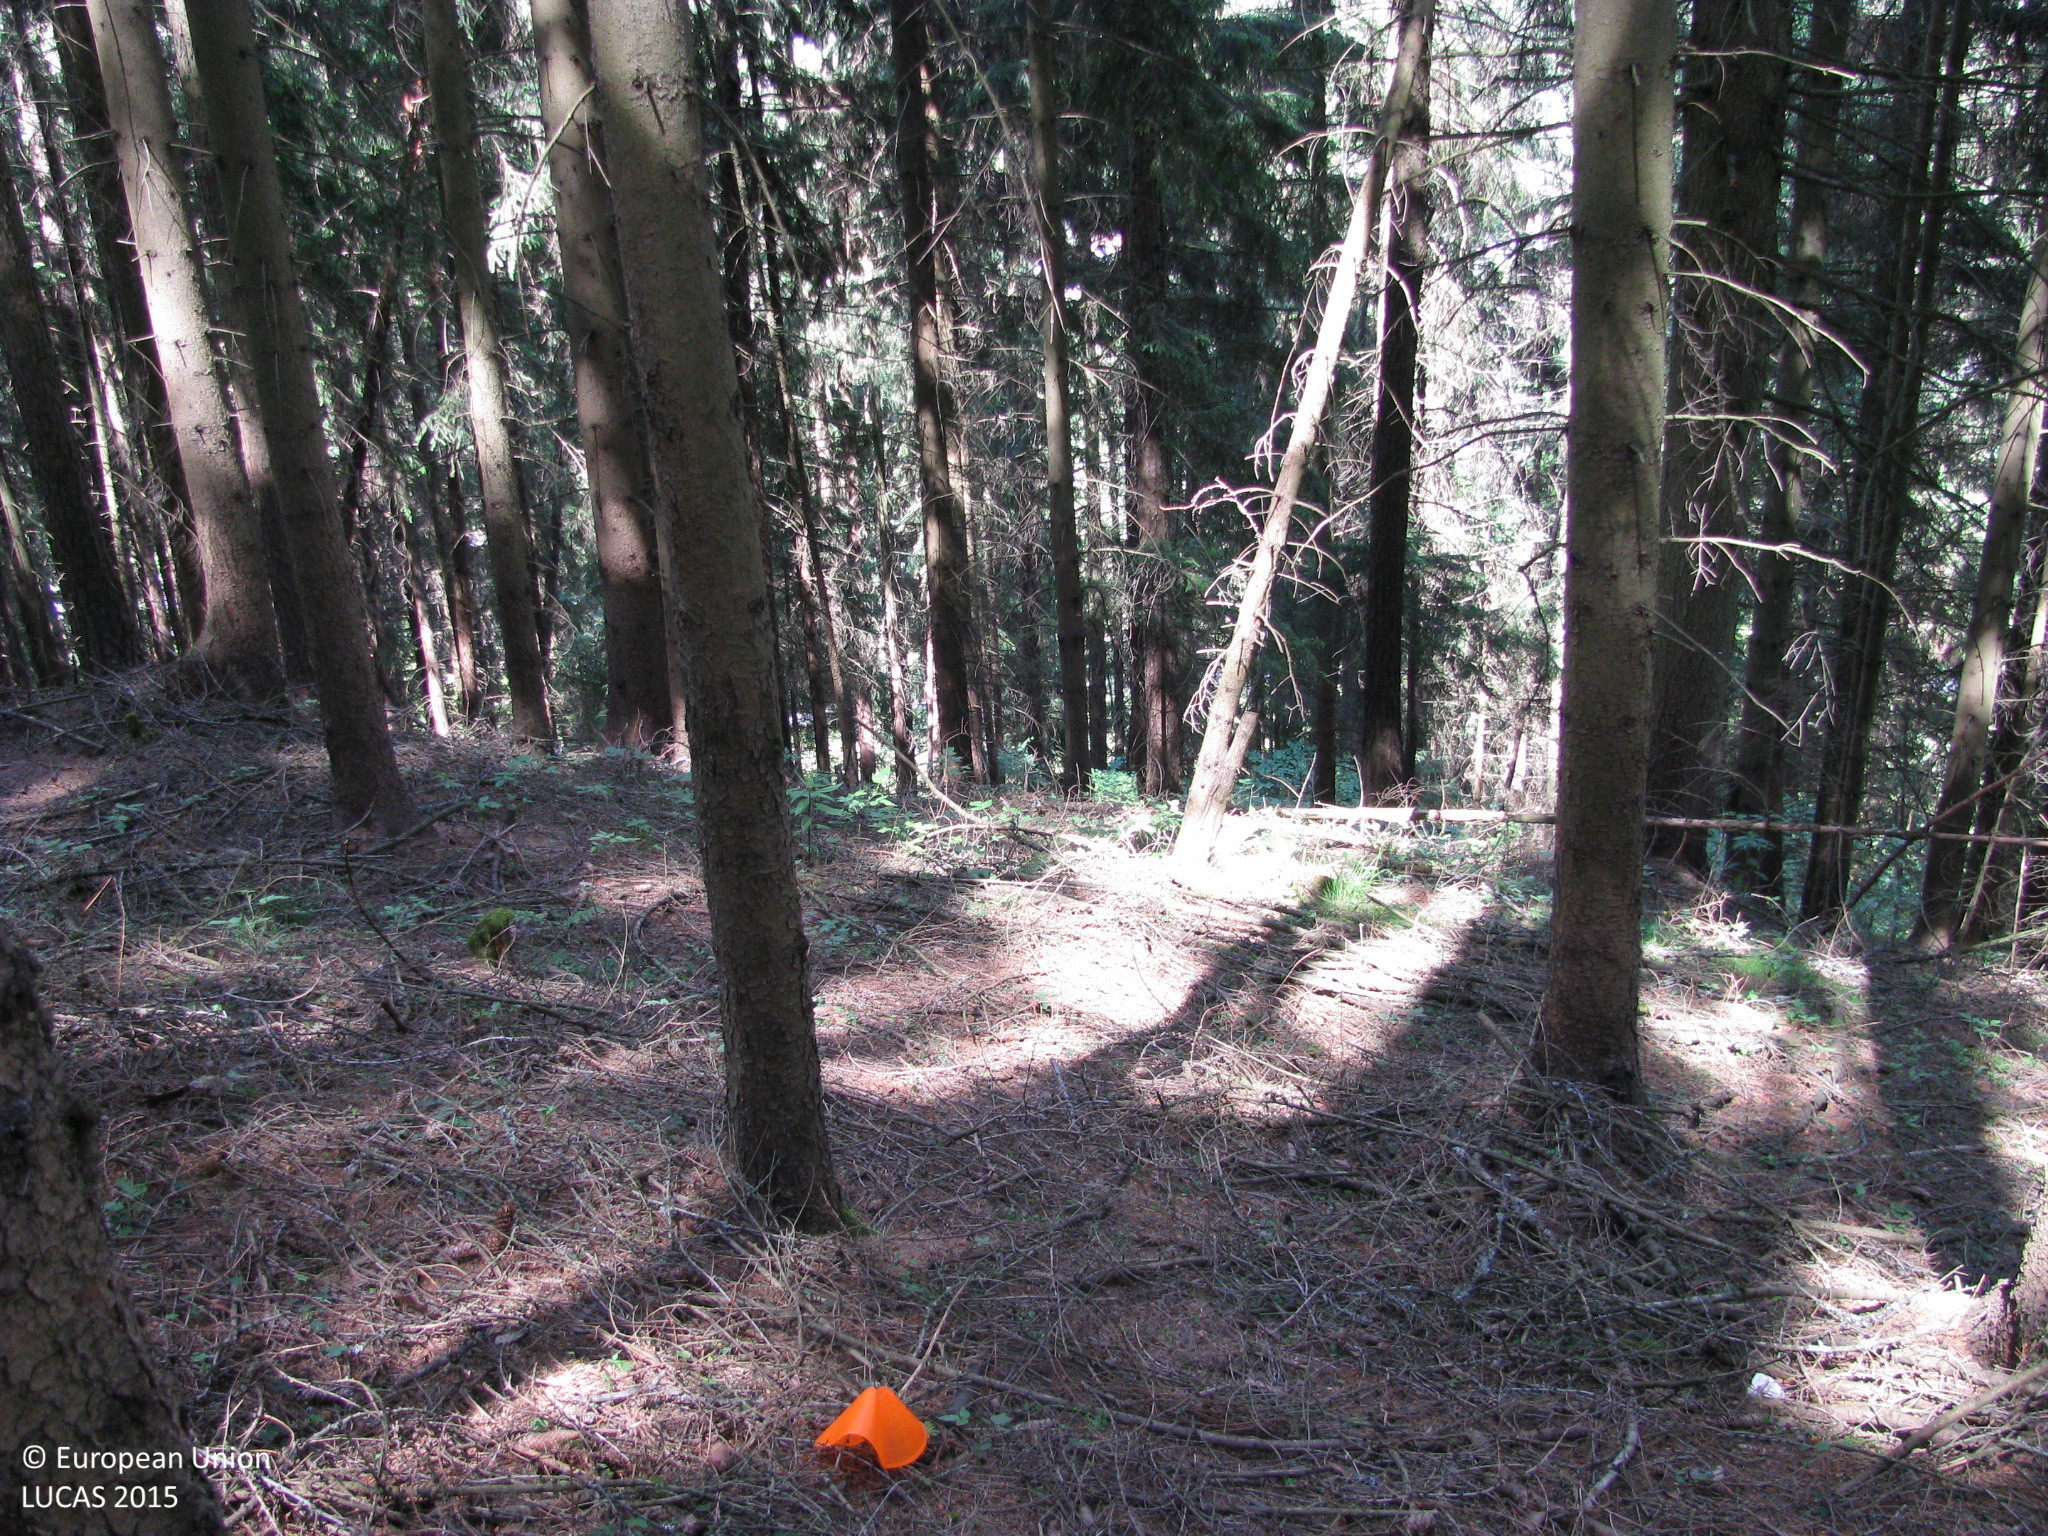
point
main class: Woodland
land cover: Spruce dominated coniferous woodland
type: alpine coniferous forest
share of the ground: > 75 %
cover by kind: coniferous forest trees 90 %, unconsolidated bare surface 10 %
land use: Forestry
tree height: > 5 m
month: June
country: AT
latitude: 47.3724
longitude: 14.9658
